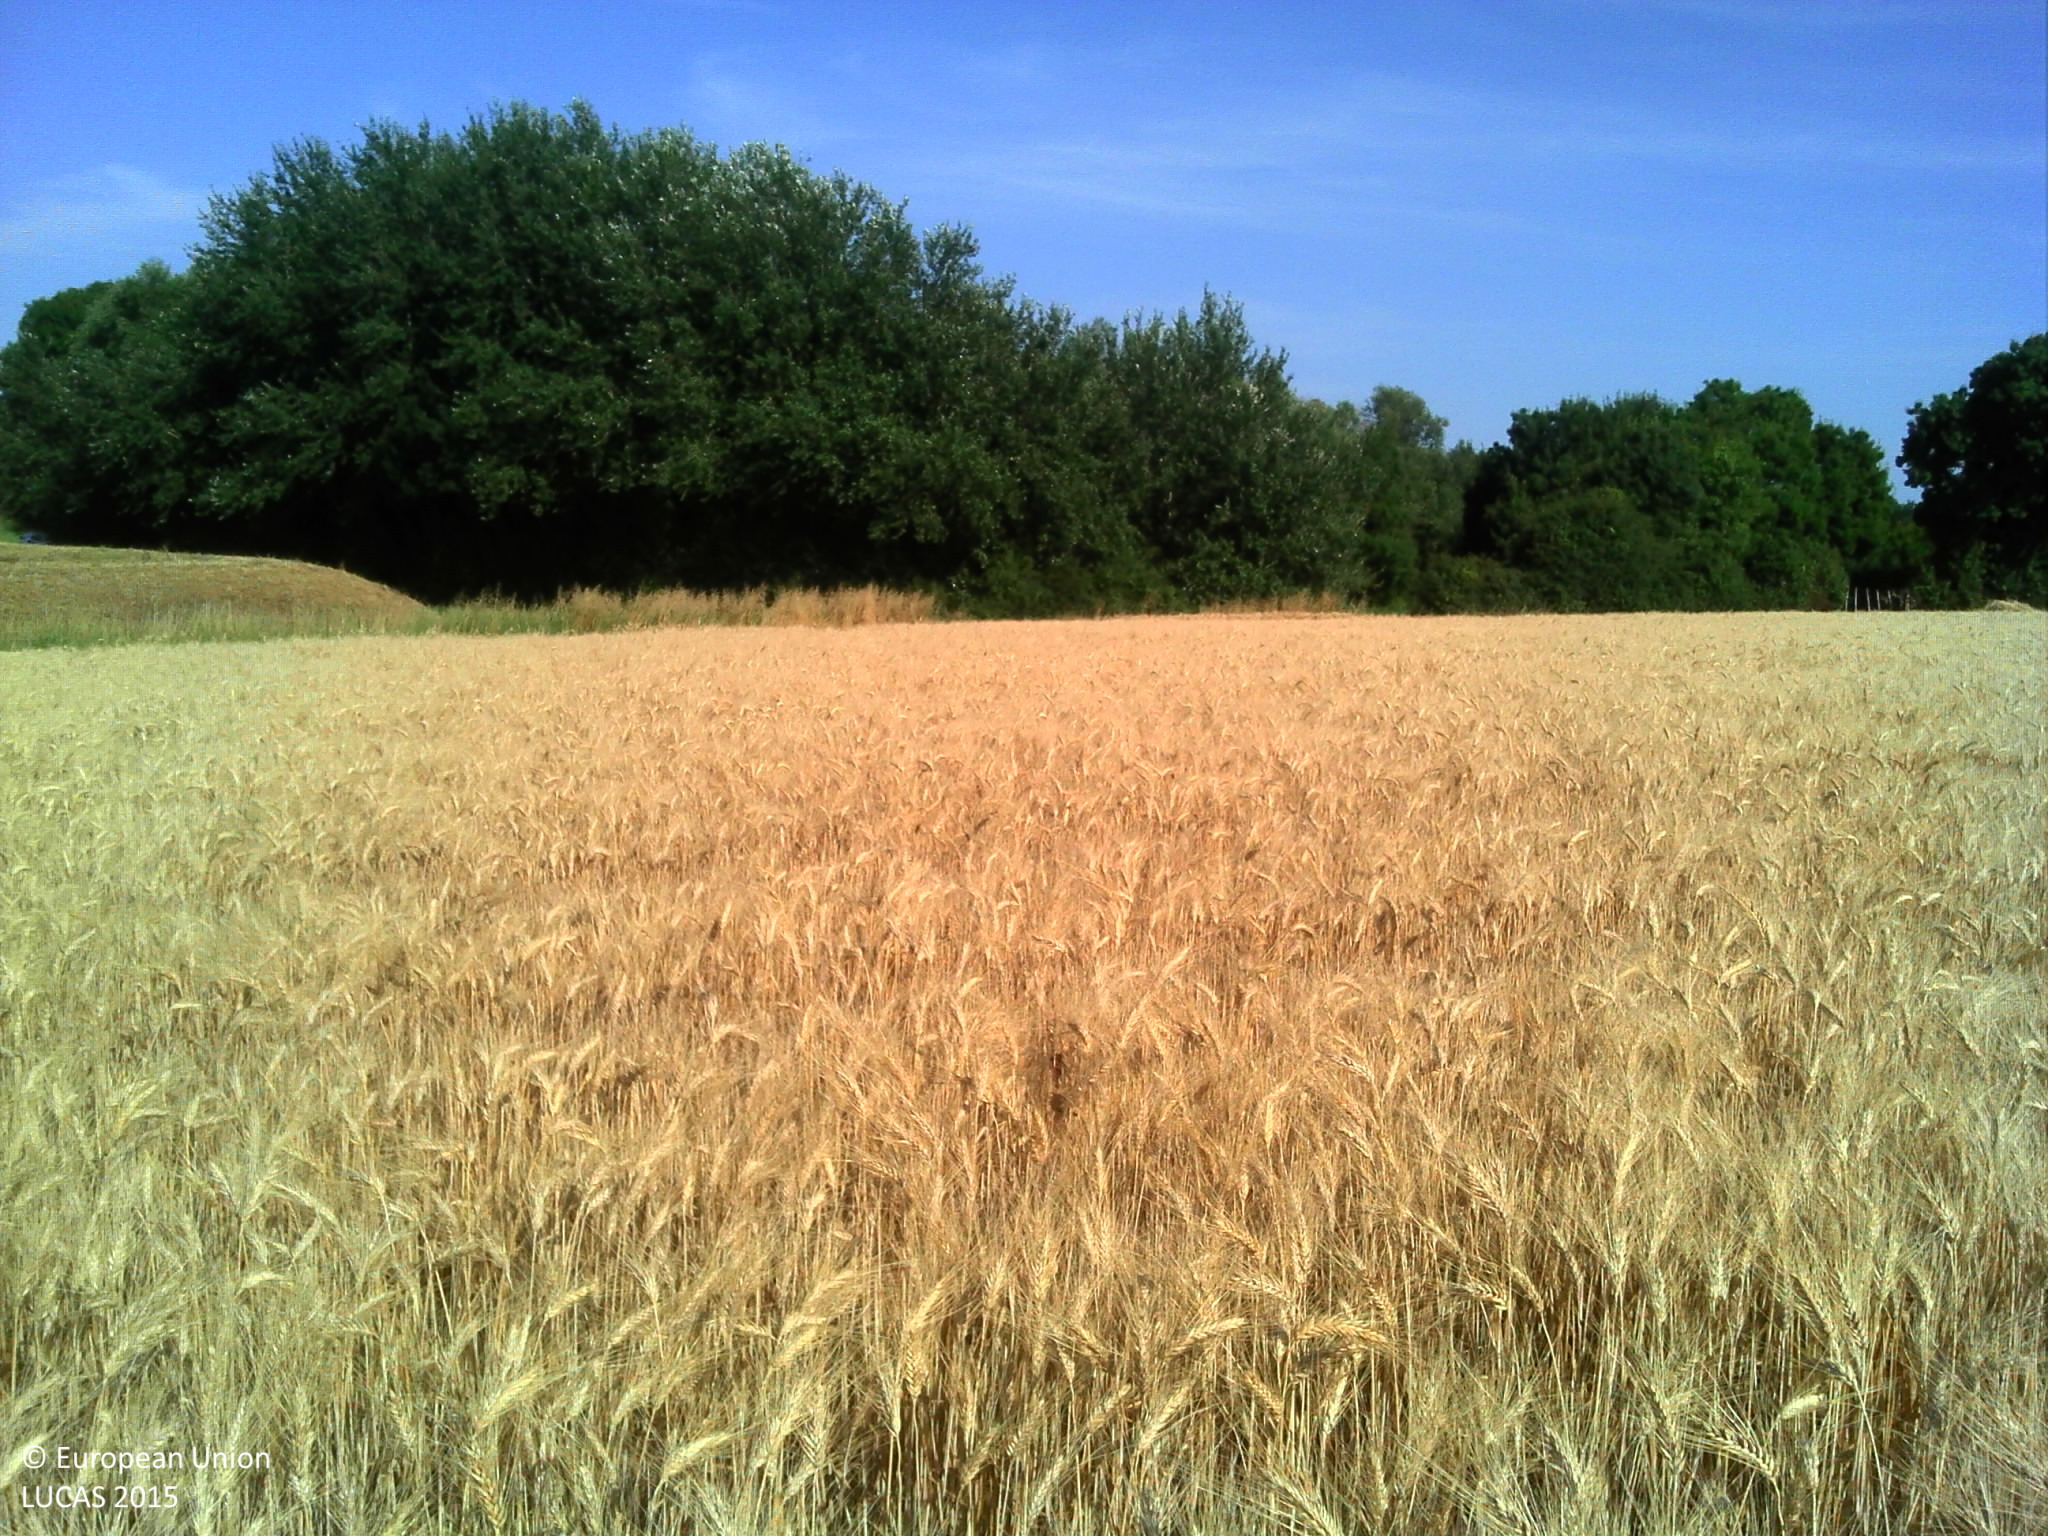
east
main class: Cropland
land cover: Common wheat
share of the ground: > 75 %
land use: Agriculture (excluding fallow land and kitchen gardens)
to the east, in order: Common wheat; Ditches and canals; Grass margins; Paved roads, cycling and walking lanes; Grass margins; Ditches and canals; Grassland without tree/shrub cover; Inland fresh water bodies; Single bushes/trees; Grassland without tree/shrub cover; Ditches and canals; Rape and turnip rape
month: July
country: FR
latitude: 46.4347
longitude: -1.5298
